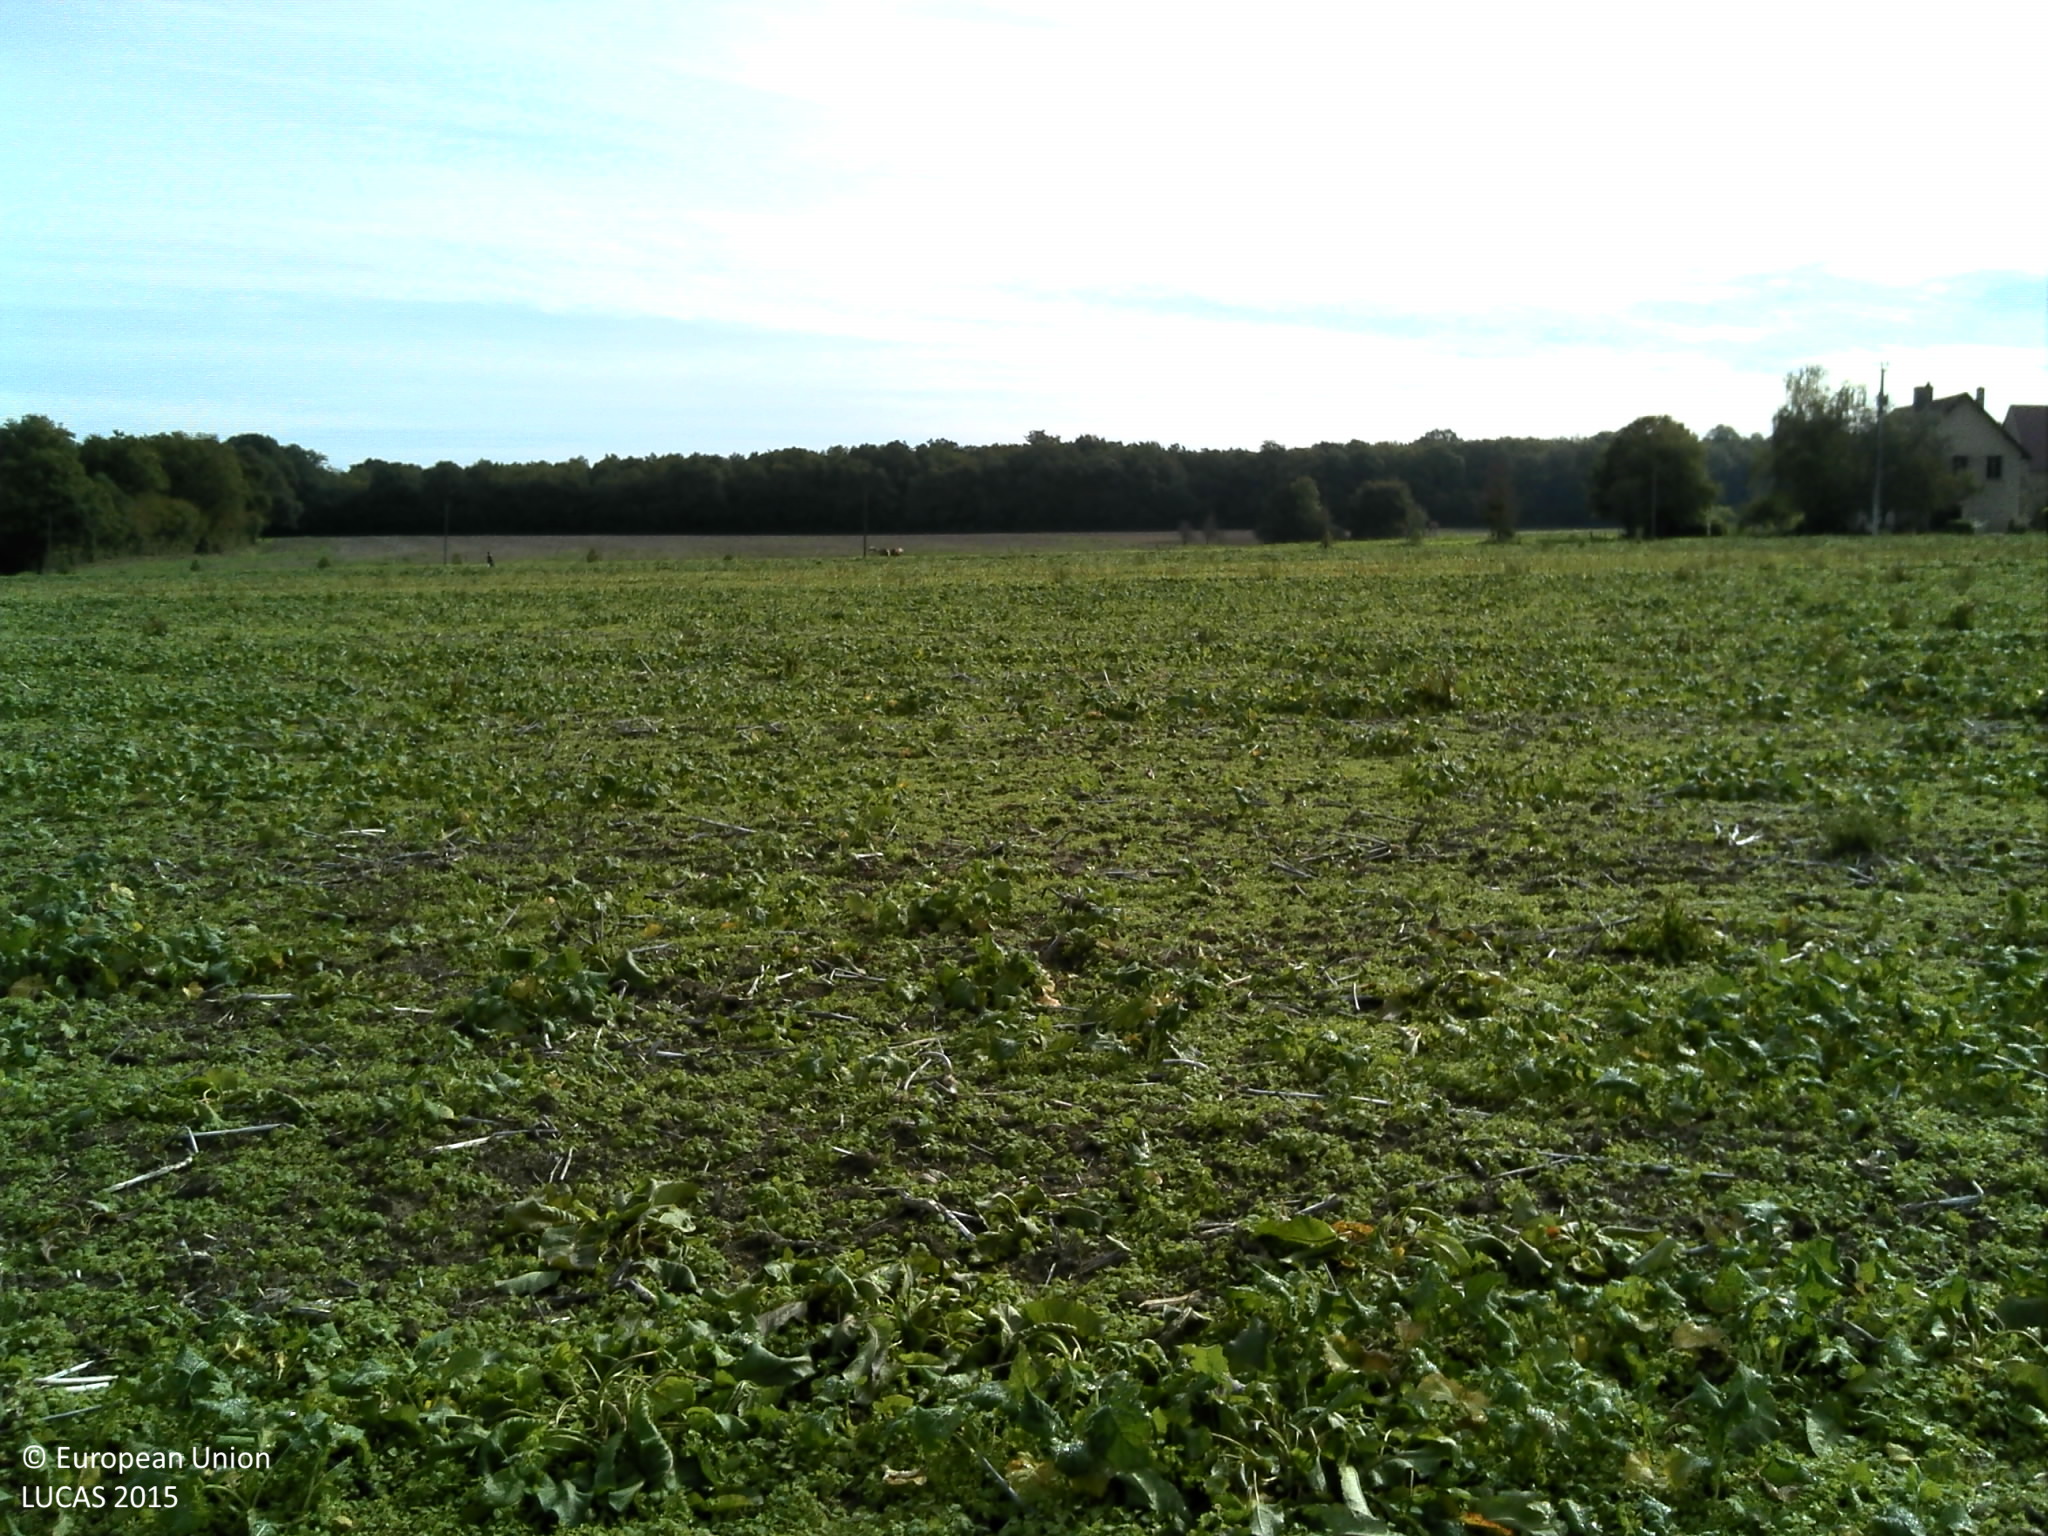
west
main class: Cropland
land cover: Rape and turnip rape
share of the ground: > 75 %
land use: Agriculture (excluding fallow land and kitchen gardens)
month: June
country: FR
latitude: 46.7111
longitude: 4.7820
